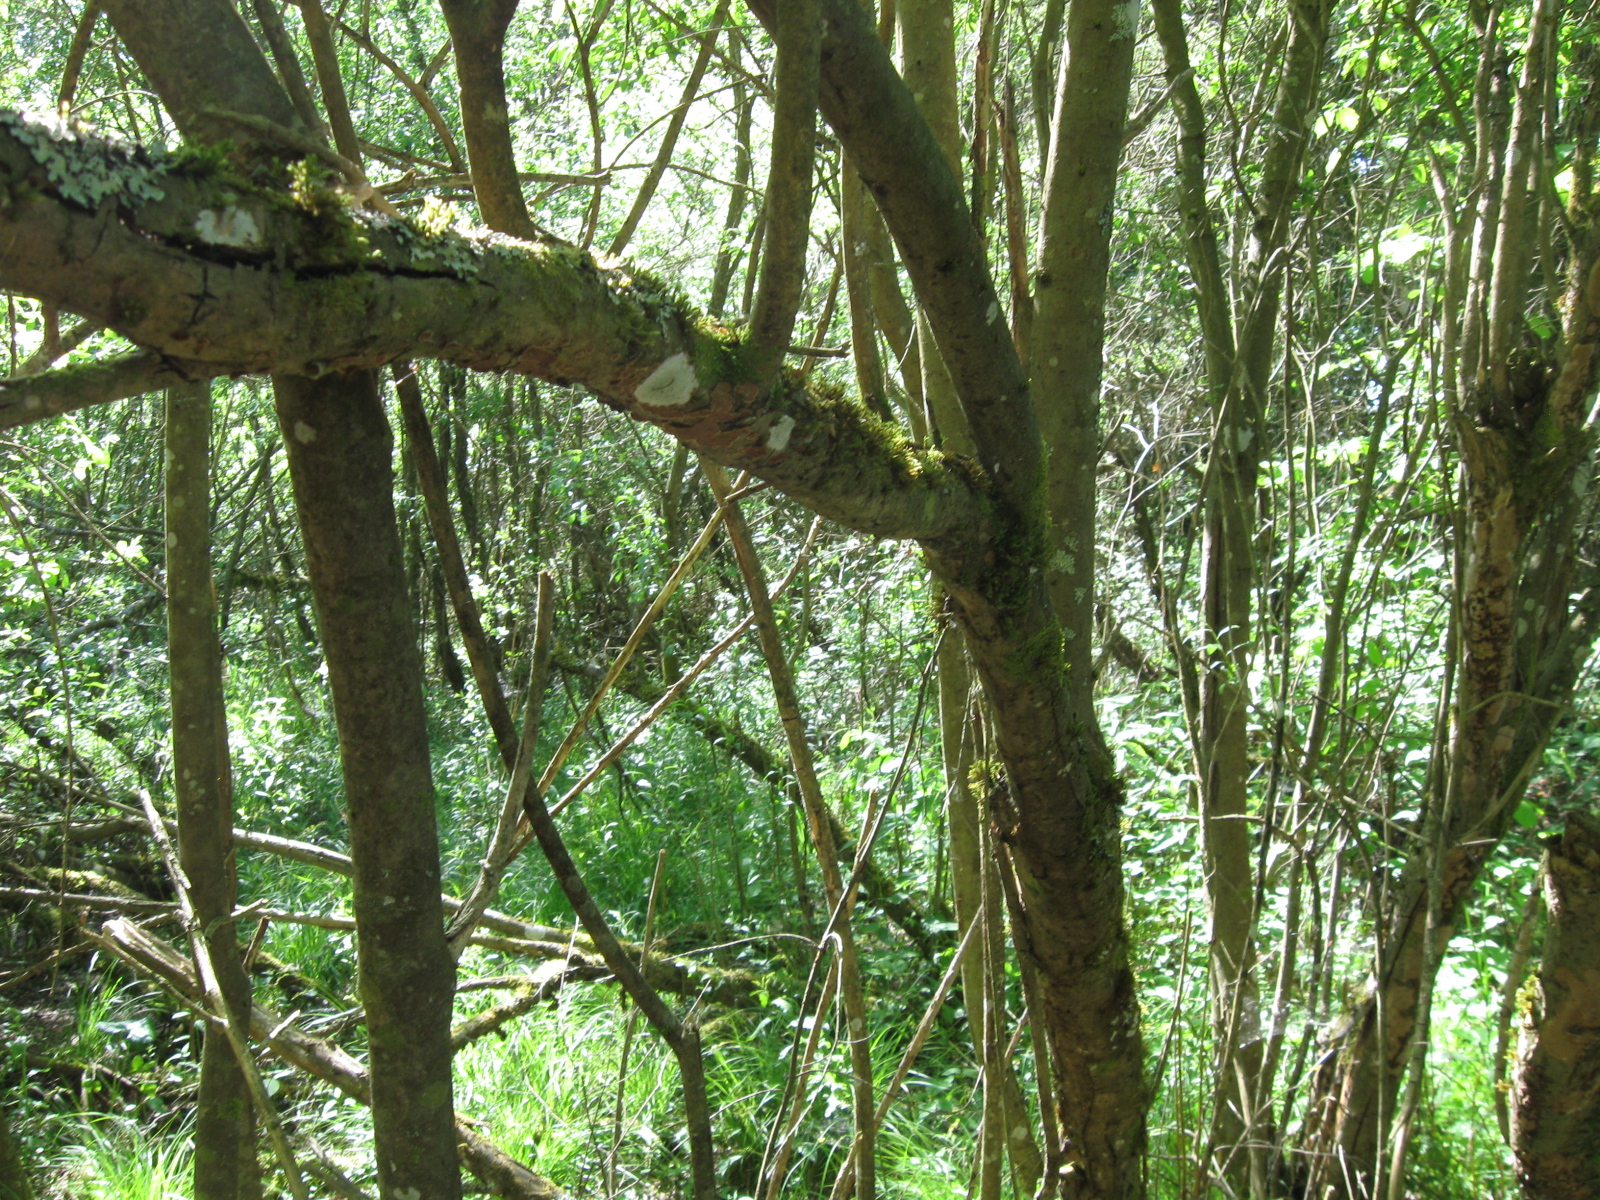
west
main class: Woodland
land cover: Spruce dominated mixed woodland
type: hemiboreal forest and nemoral coniferous forest and mixed broadleaved-coniferous forest
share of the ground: > 75 %
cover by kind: broadleaved forest trees 65 %, coniferous forest trees 30 %, herbaceous plants 5 %
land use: Forestry
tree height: > 5 m
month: June
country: LT
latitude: 54.1058
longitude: 23.6207
